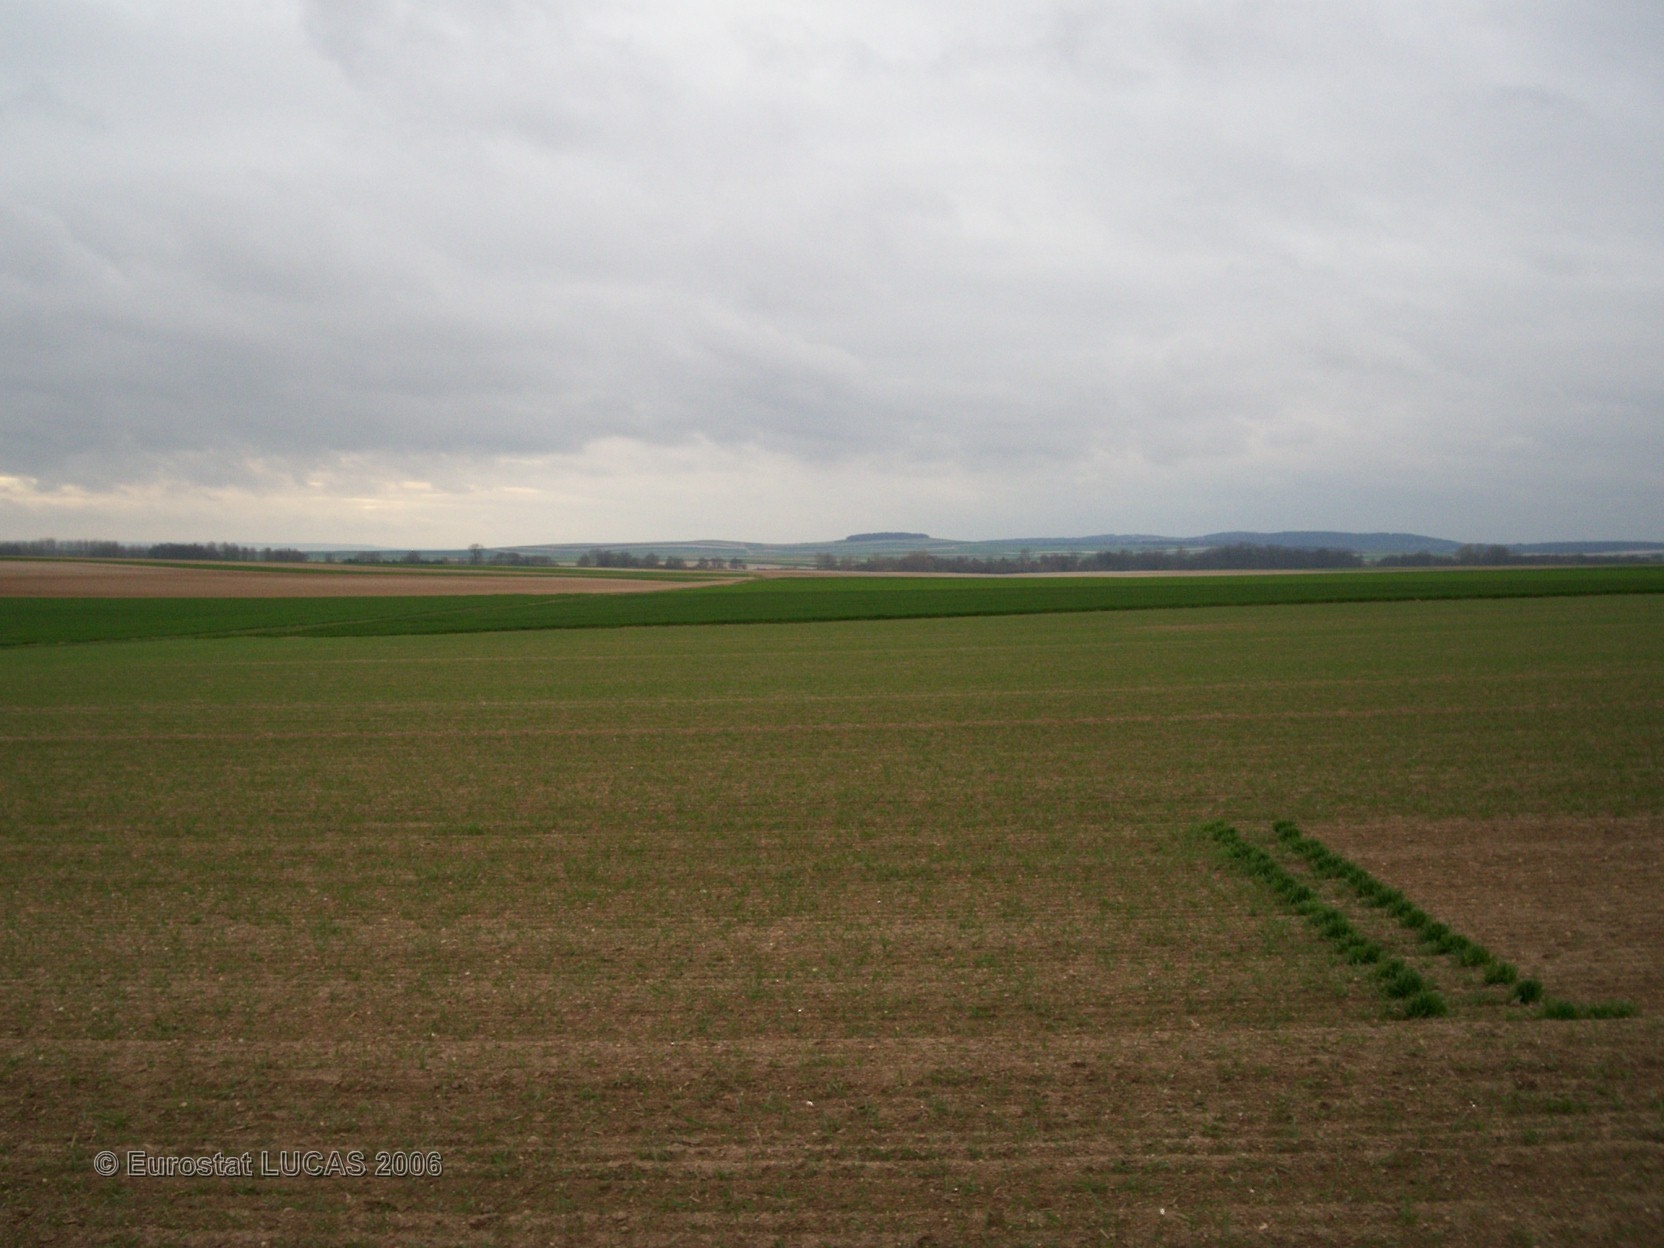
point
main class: Cropland
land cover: Barley
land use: Agriculture (excluding fallow land and kitchen gardens)
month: April
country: FR
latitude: 49.2191
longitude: 4.4359
